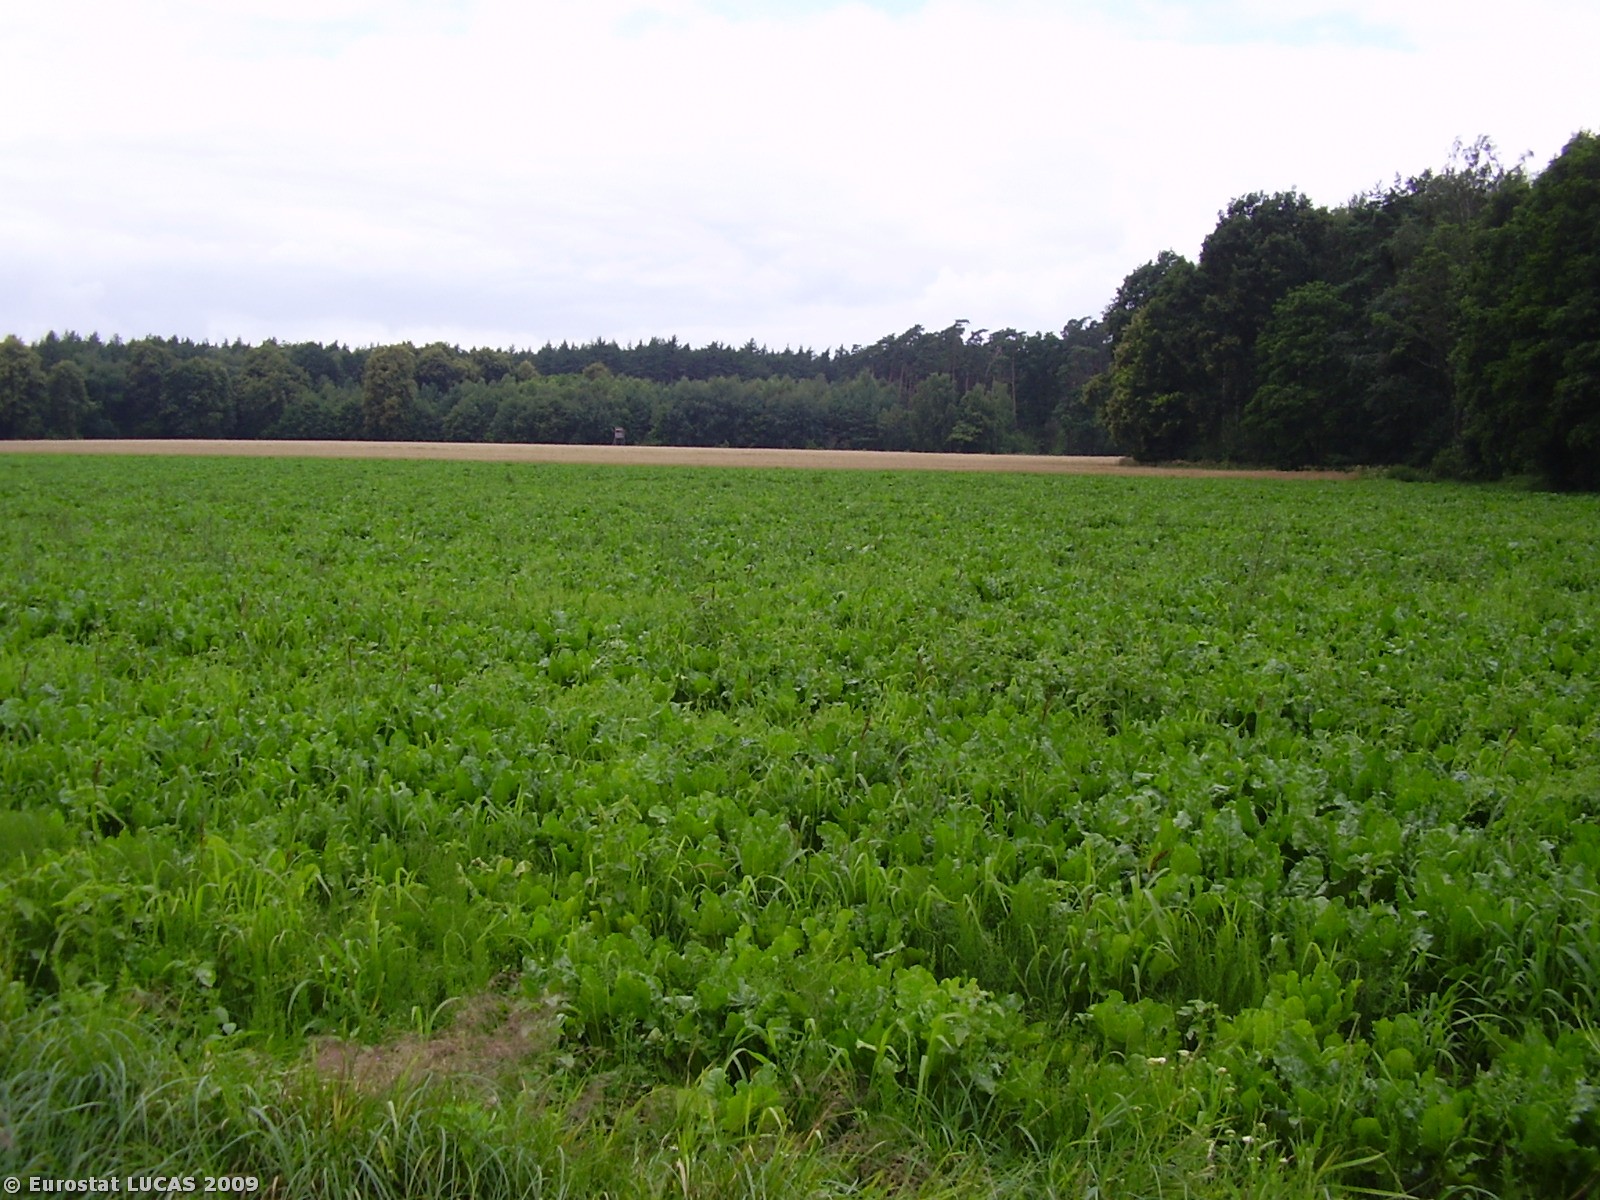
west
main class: Cropland
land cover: Triticale
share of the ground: > 75 %
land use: Agriculture (excluding fallow land and kitchen gardens)
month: July
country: PL
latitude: 51.2259
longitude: 17.6748
